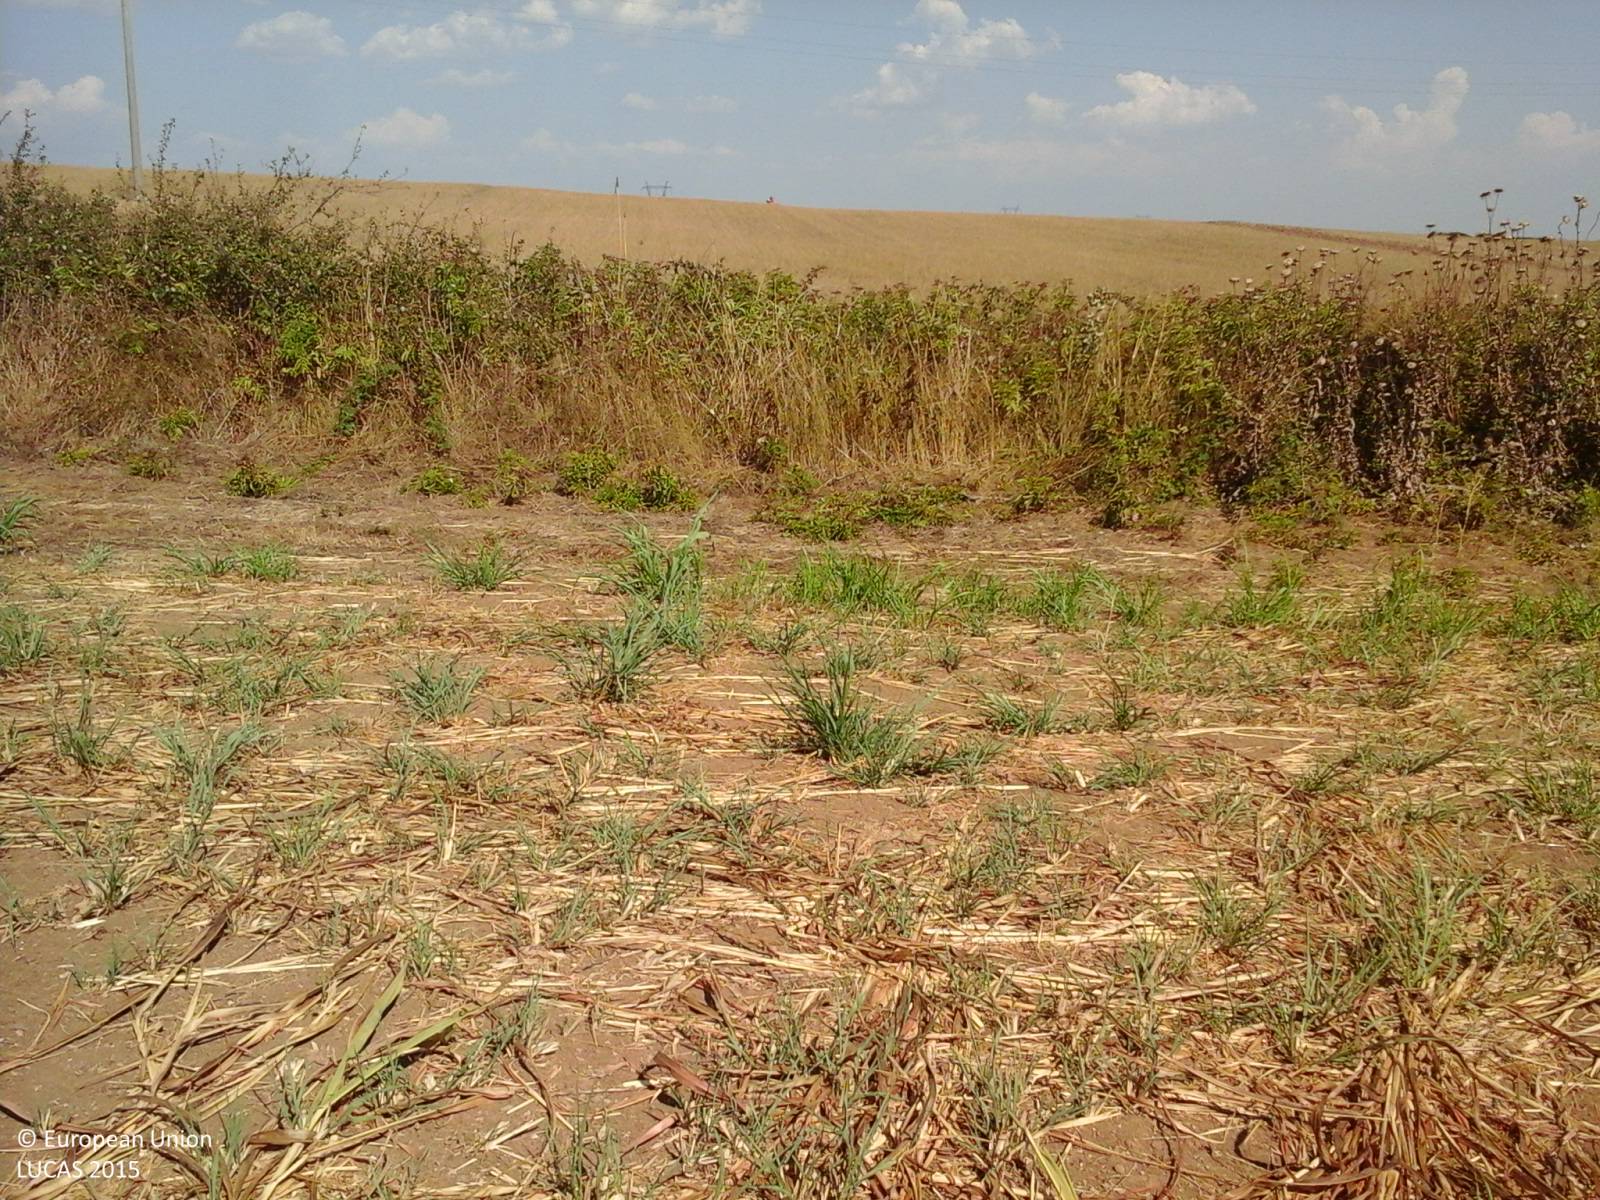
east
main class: Cropland
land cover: Maize
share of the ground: > 75 %
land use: Agriculture (excluding fallow land and kitchen gardens)
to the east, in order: Maize; Abandoned hedges; Ditches and canals; Other cereals; Electric lines; Other cereals
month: August
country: IT
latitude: 42.0513
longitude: 12.2271
